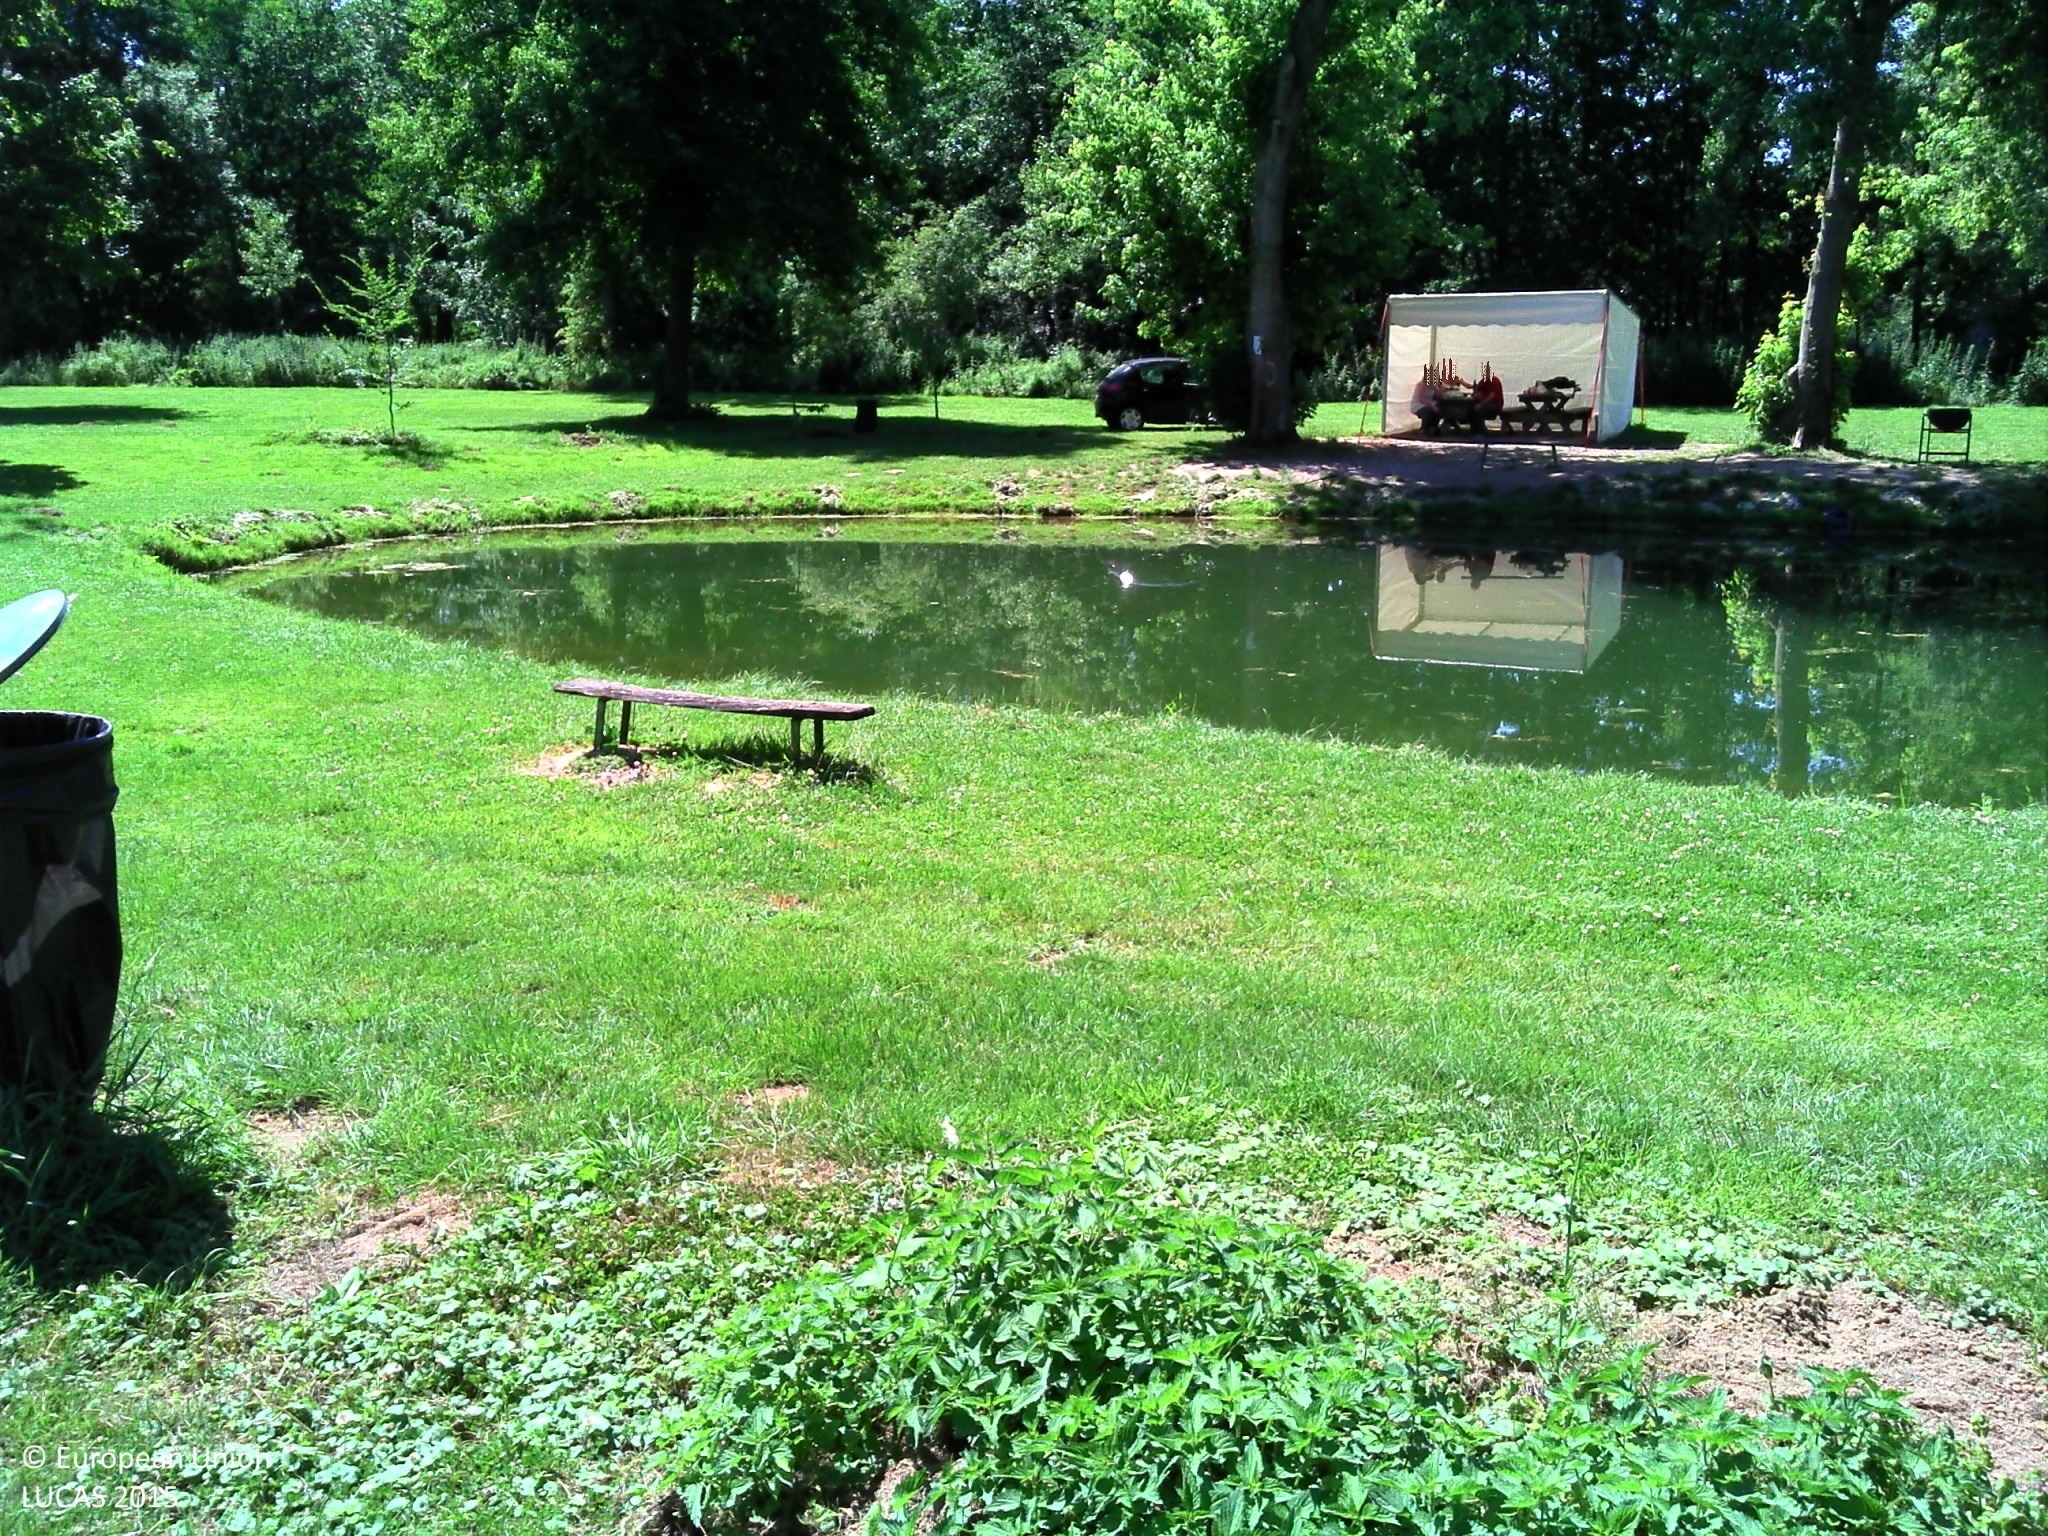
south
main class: Grassland
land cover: Grassland with sparse tree/shrub cover
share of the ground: > 75 %
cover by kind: herbaceous plants 95 %, broadleaved forest trees 5 %
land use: Amenities, museums, leisure
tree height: > 5 m
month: July
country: FR
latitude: 50.3456
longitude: 2.1299
